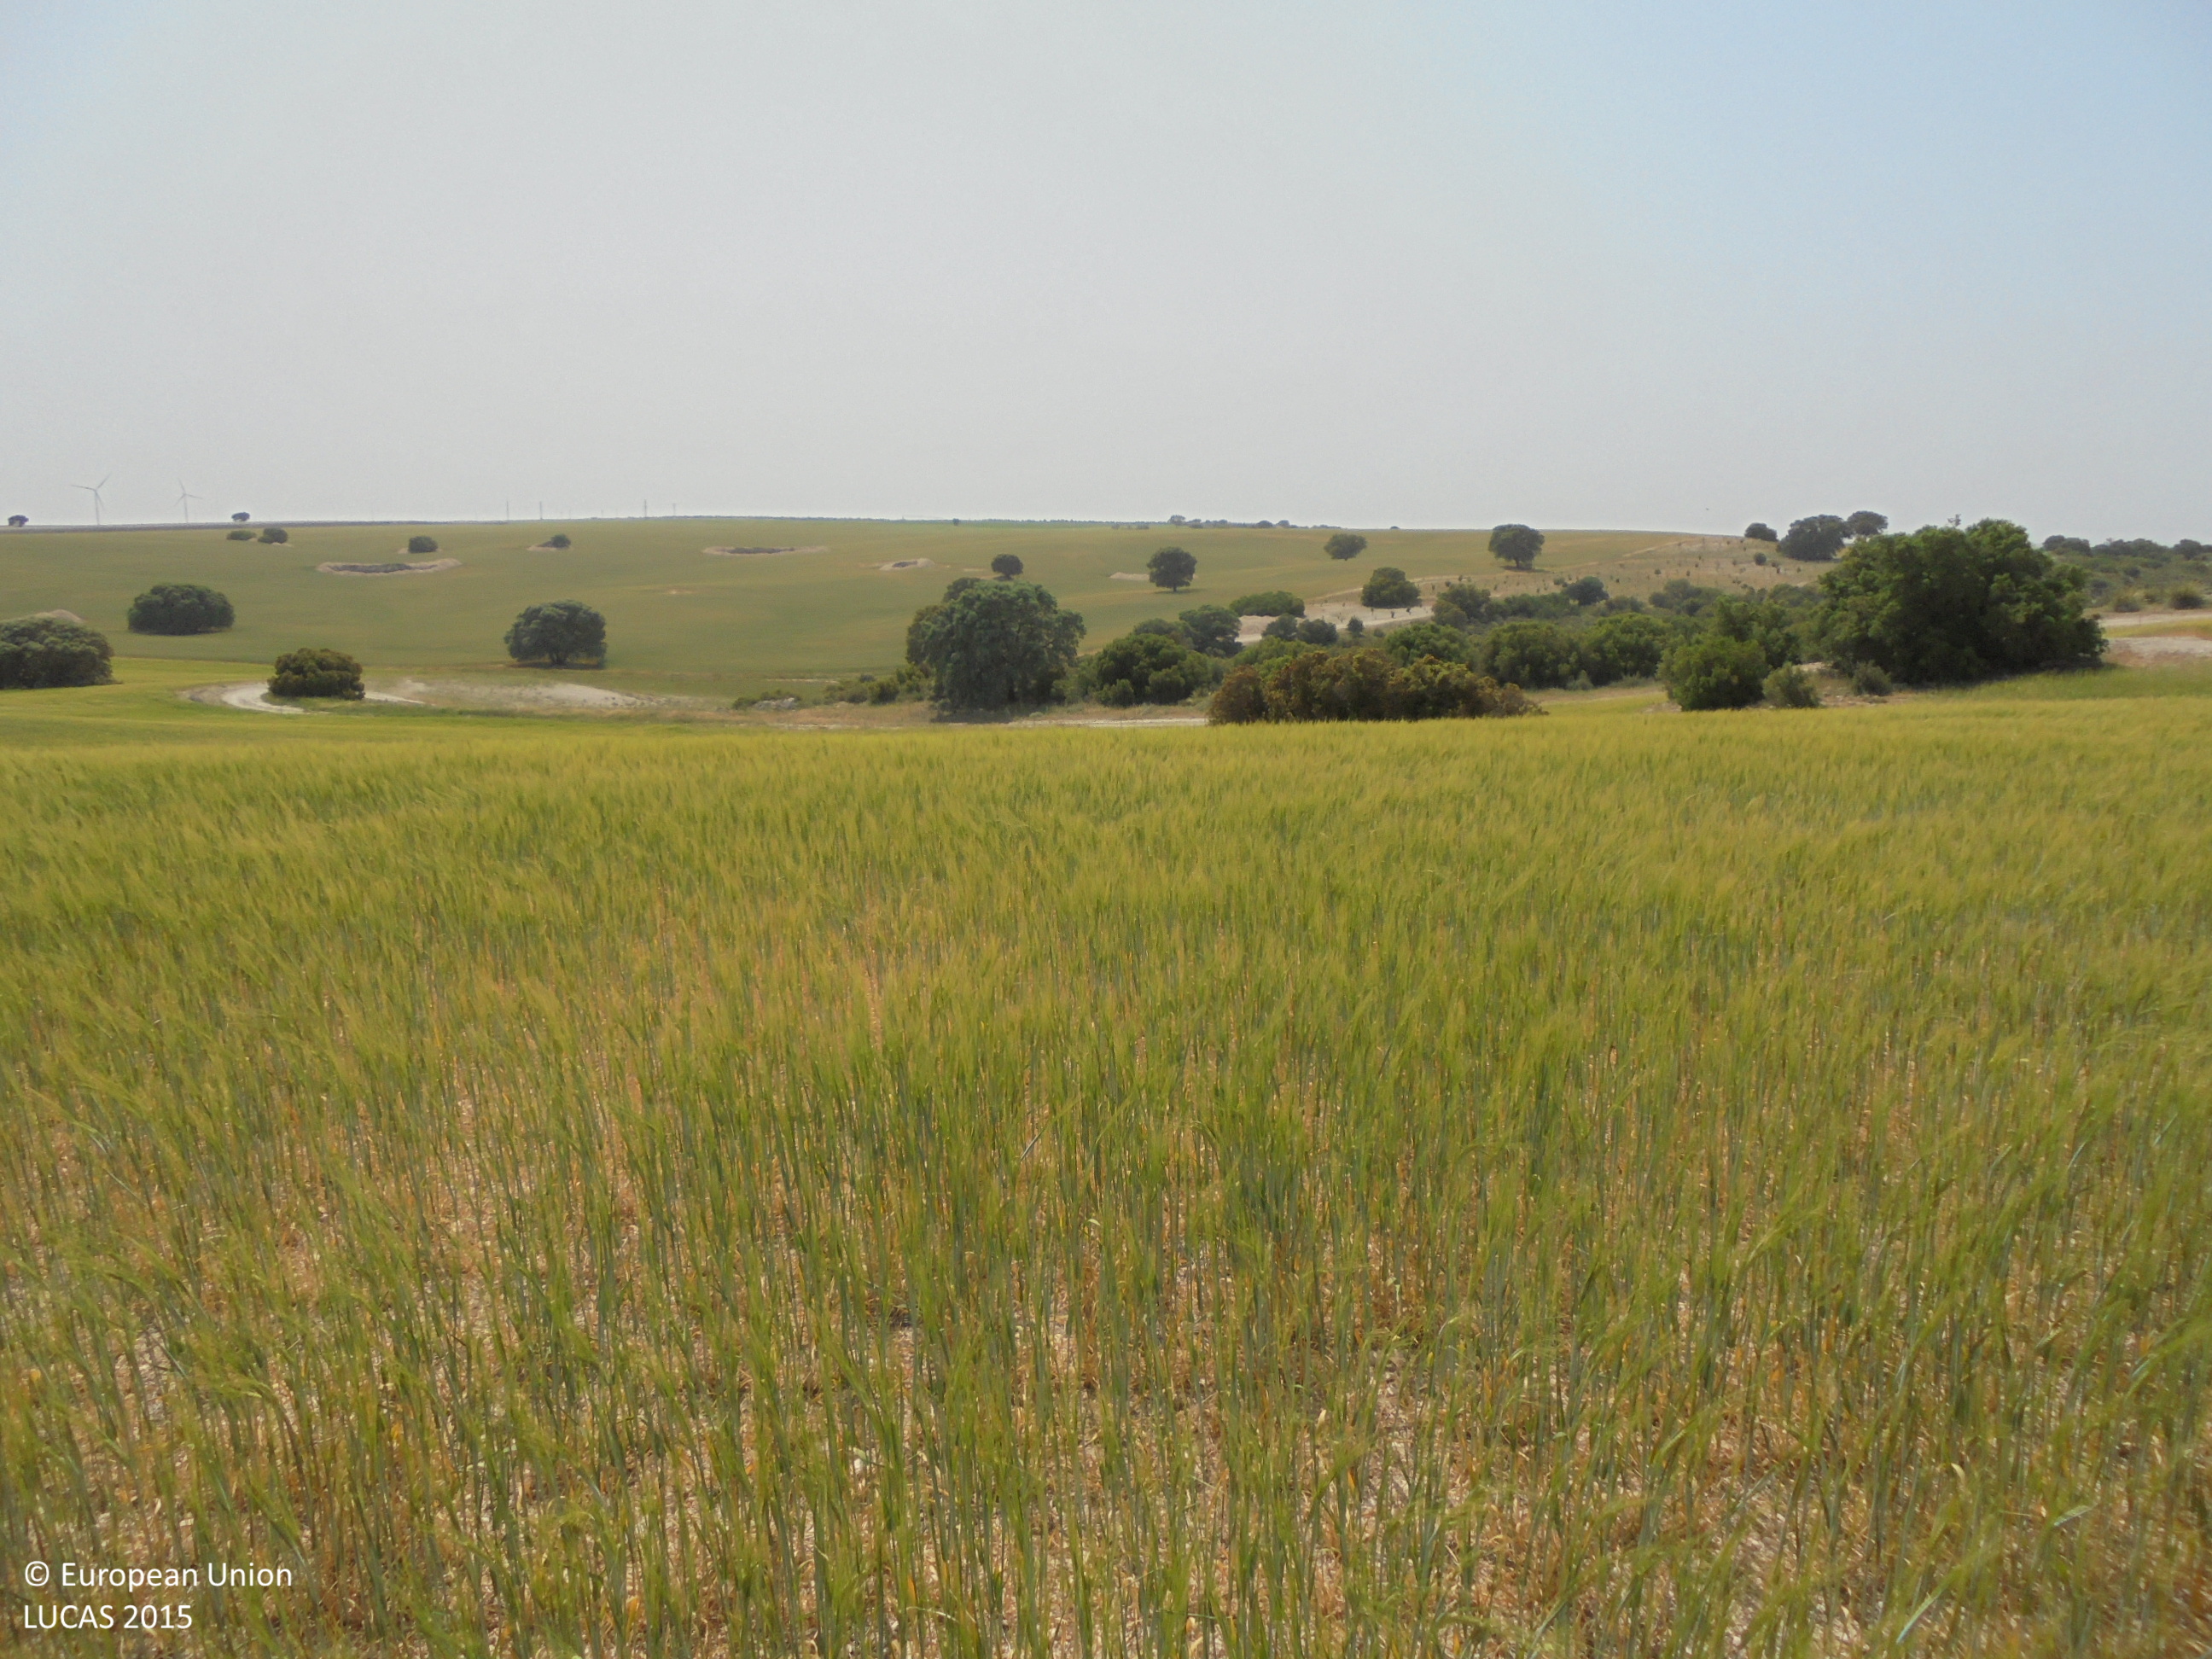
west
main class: Cropland
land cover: Barley
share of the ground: 50 - 75 %
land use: Agriculture (excluding fallow land and kitchen gardens)
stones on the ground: > 50 %
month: May
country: ES
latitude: 39.0704
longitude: -1.7087
